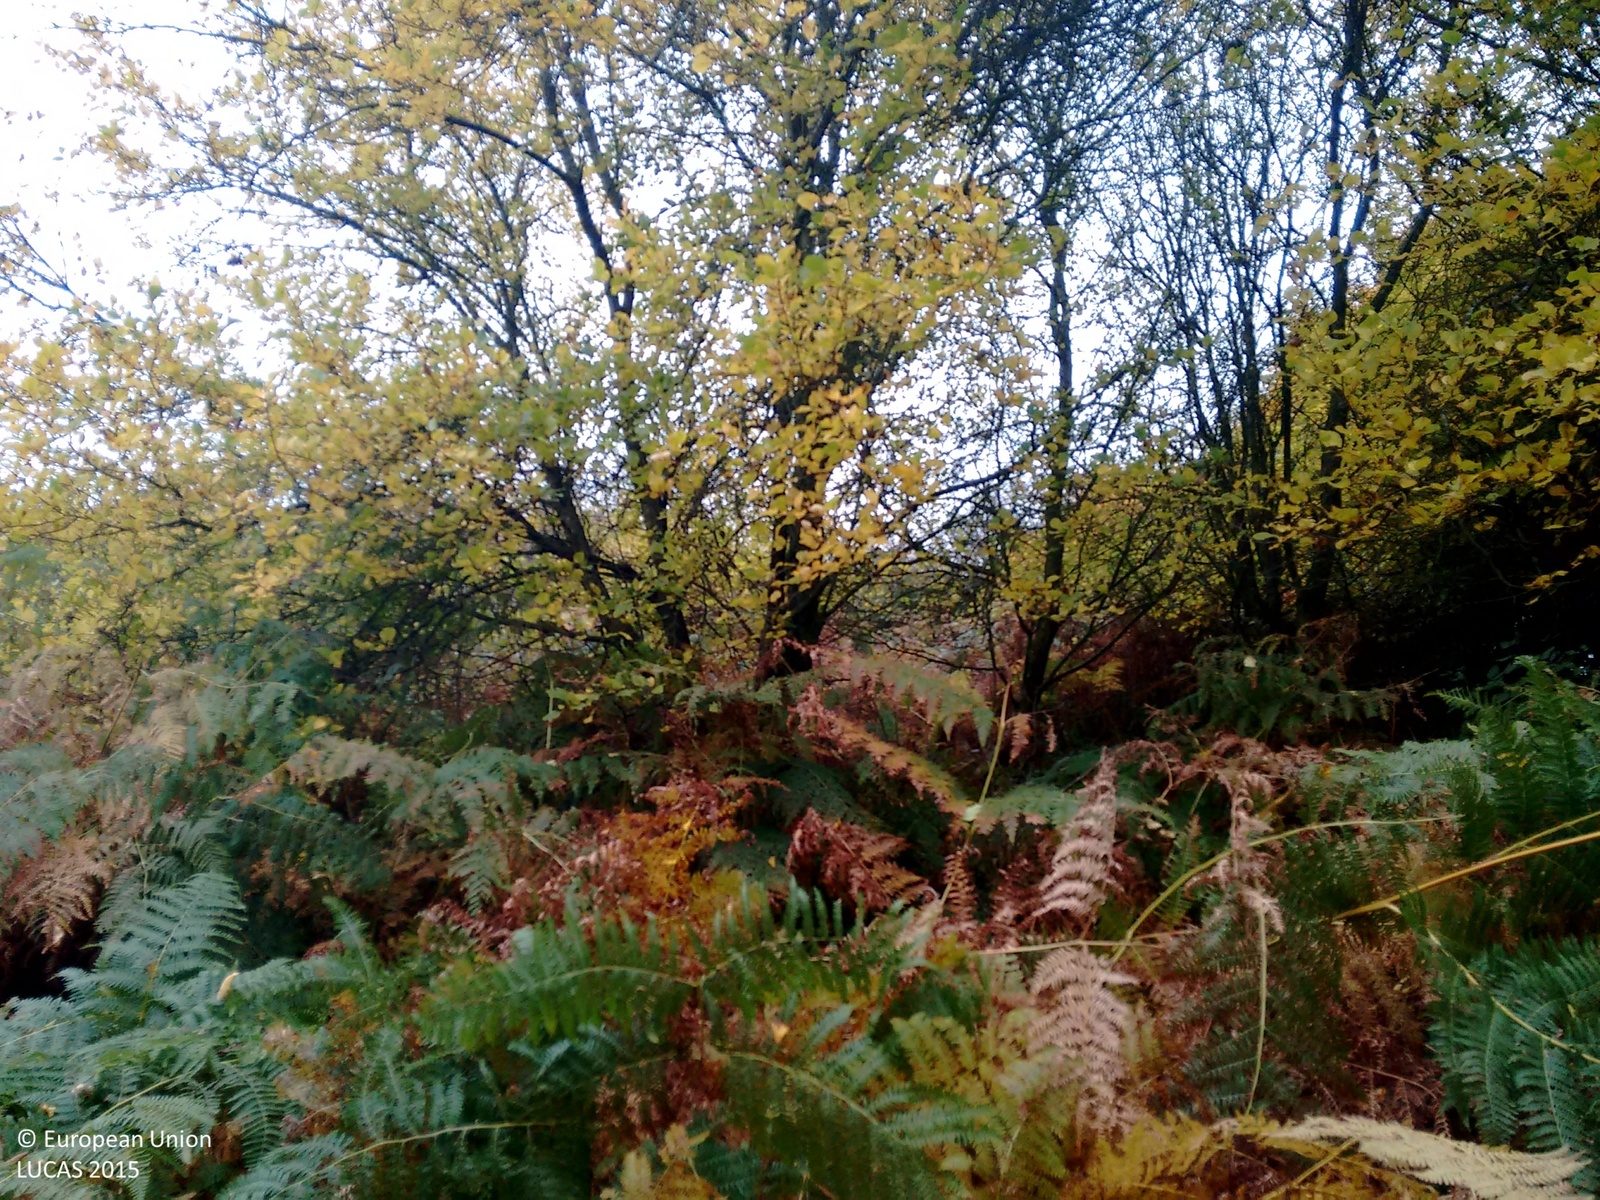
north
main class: Shrubland
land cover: Shrubland without tree cover
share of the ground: > 75 %
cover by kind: herbaceous plants 80 %, shrubs 20 %
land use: Semi-natural and natural areas not in use
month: October
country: GB
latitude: 52.4044
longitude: -2.8456
